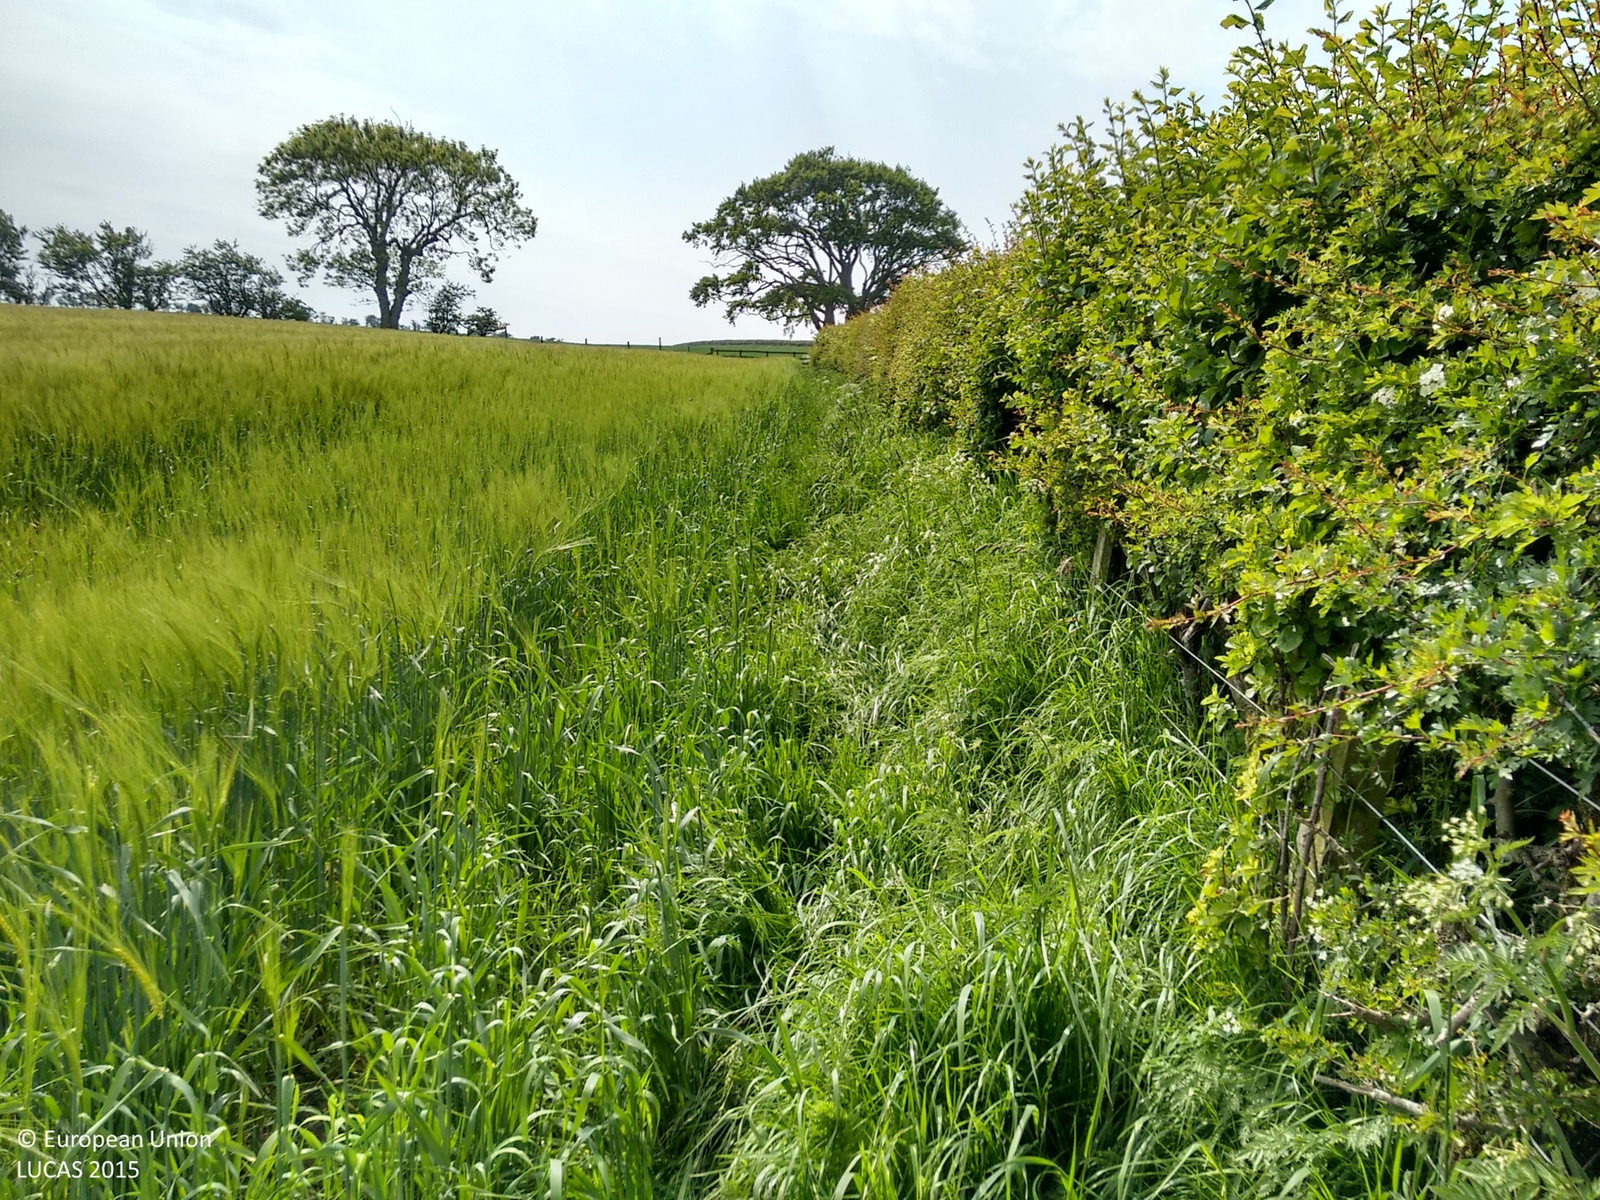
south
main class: Cropland
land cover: Barley
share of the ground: > 75 %
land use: Agriculture (excluding fallow land and kitchen gardens)
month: June
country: GB
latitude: 55.5358
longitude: -1.7589
